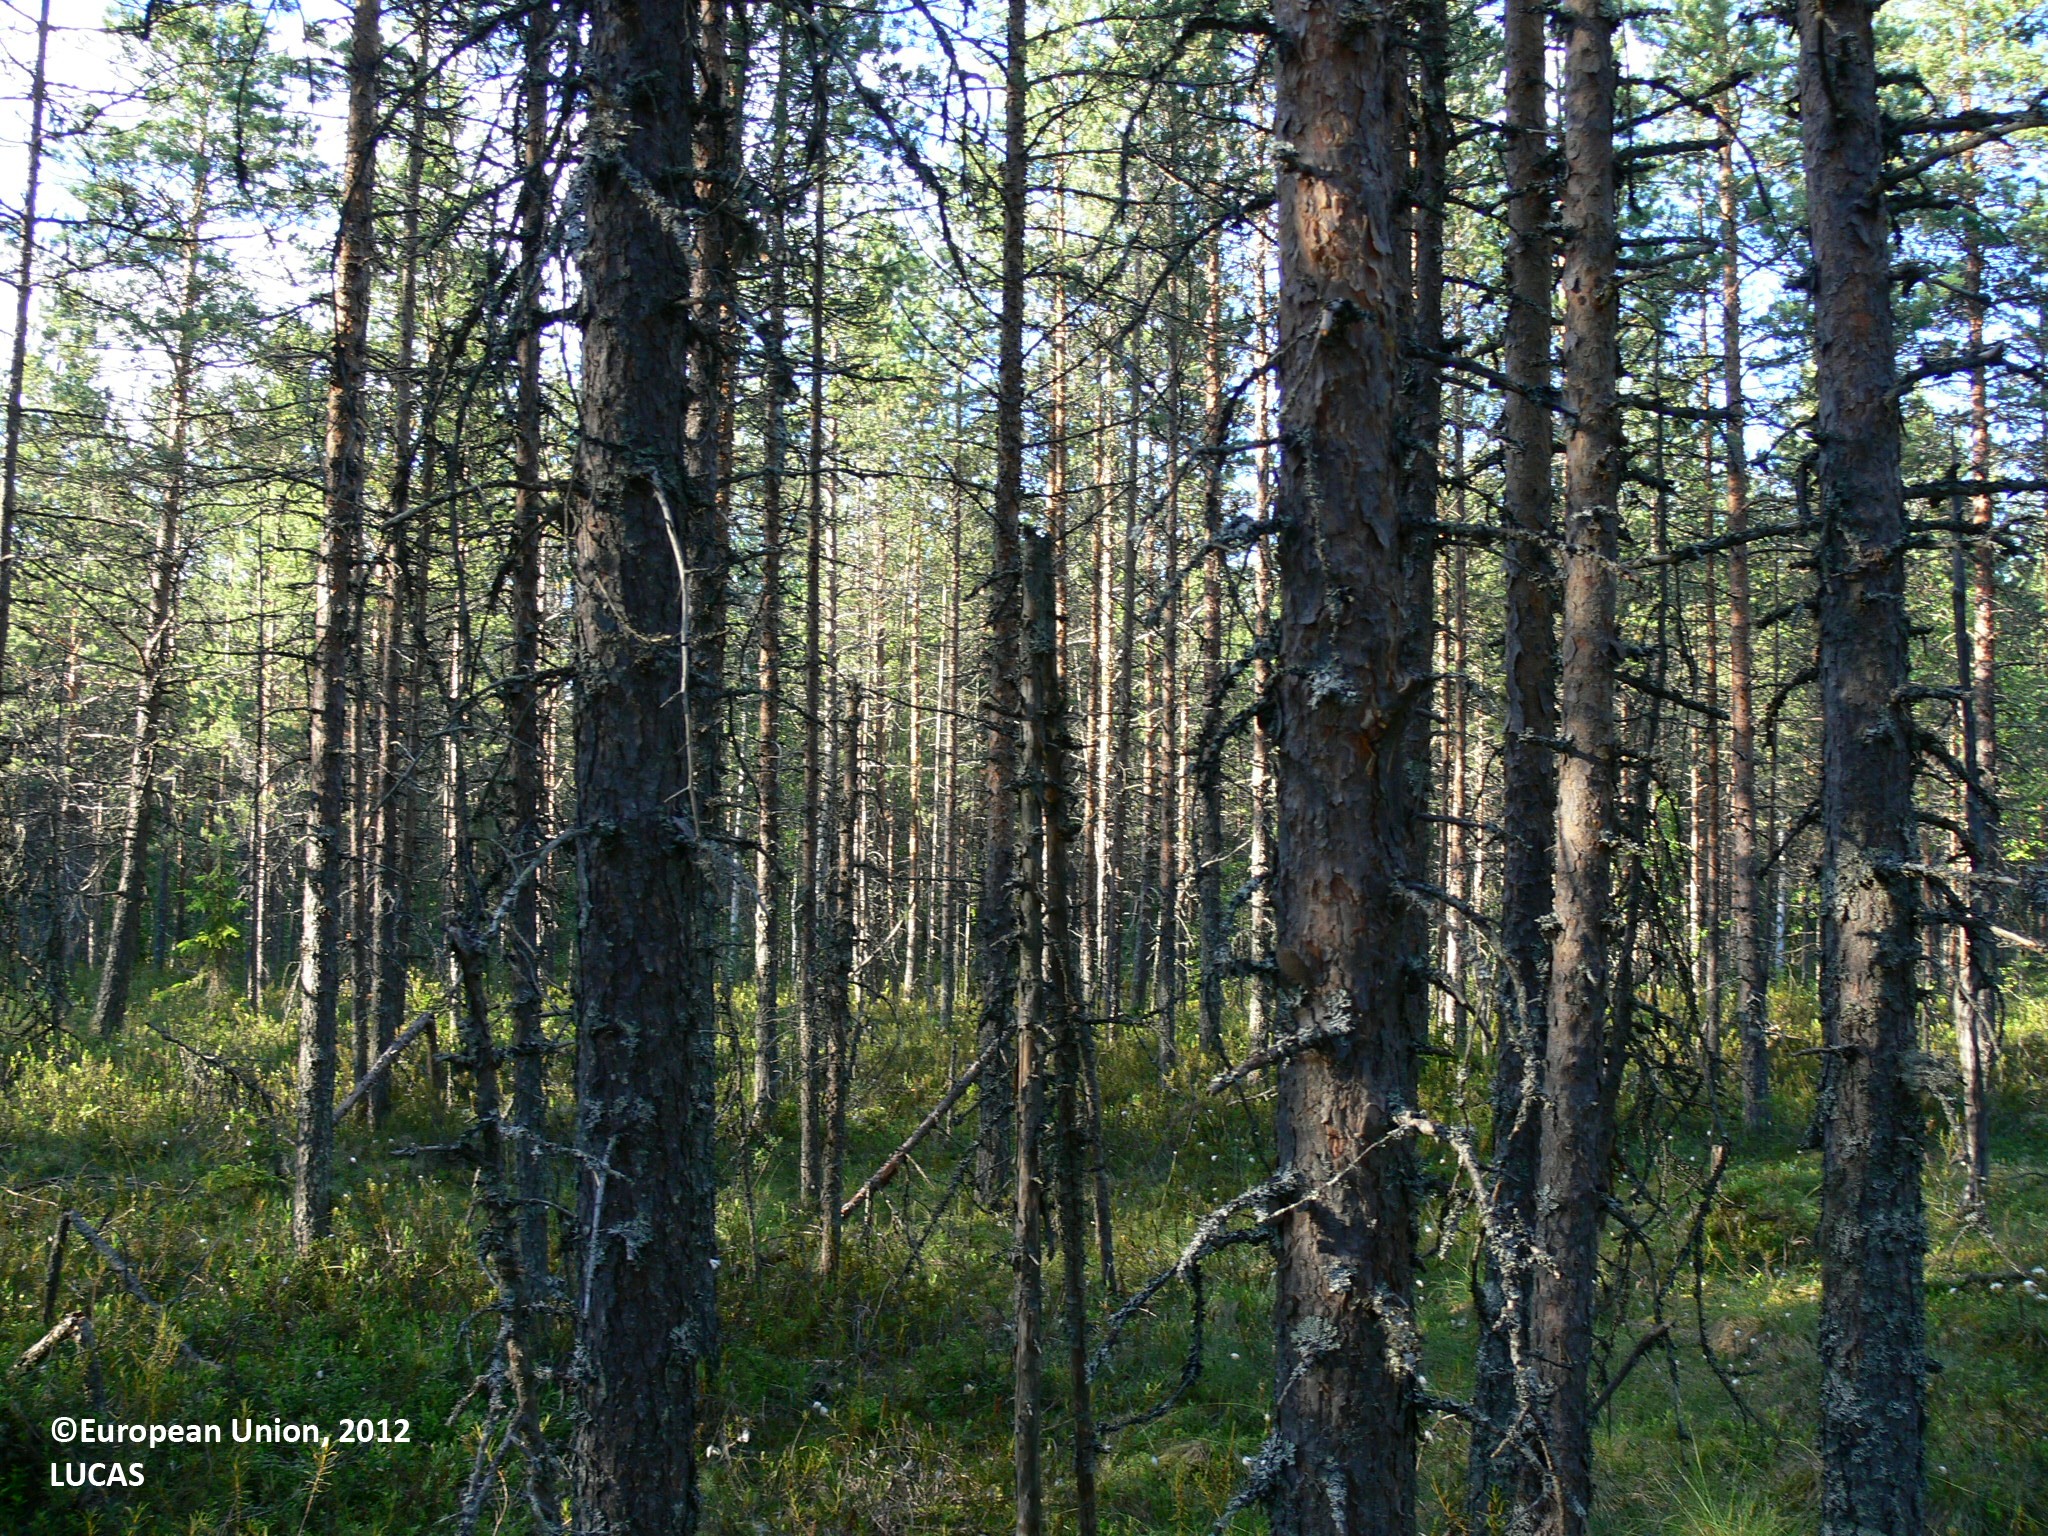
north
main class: Woodland
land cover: Pine dominated coniferous woodland
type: boreal forest
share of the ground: > 75 %
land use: Forestry
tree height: > 5 m
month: July
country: FI
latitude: 62.9037
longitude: 31.0238
